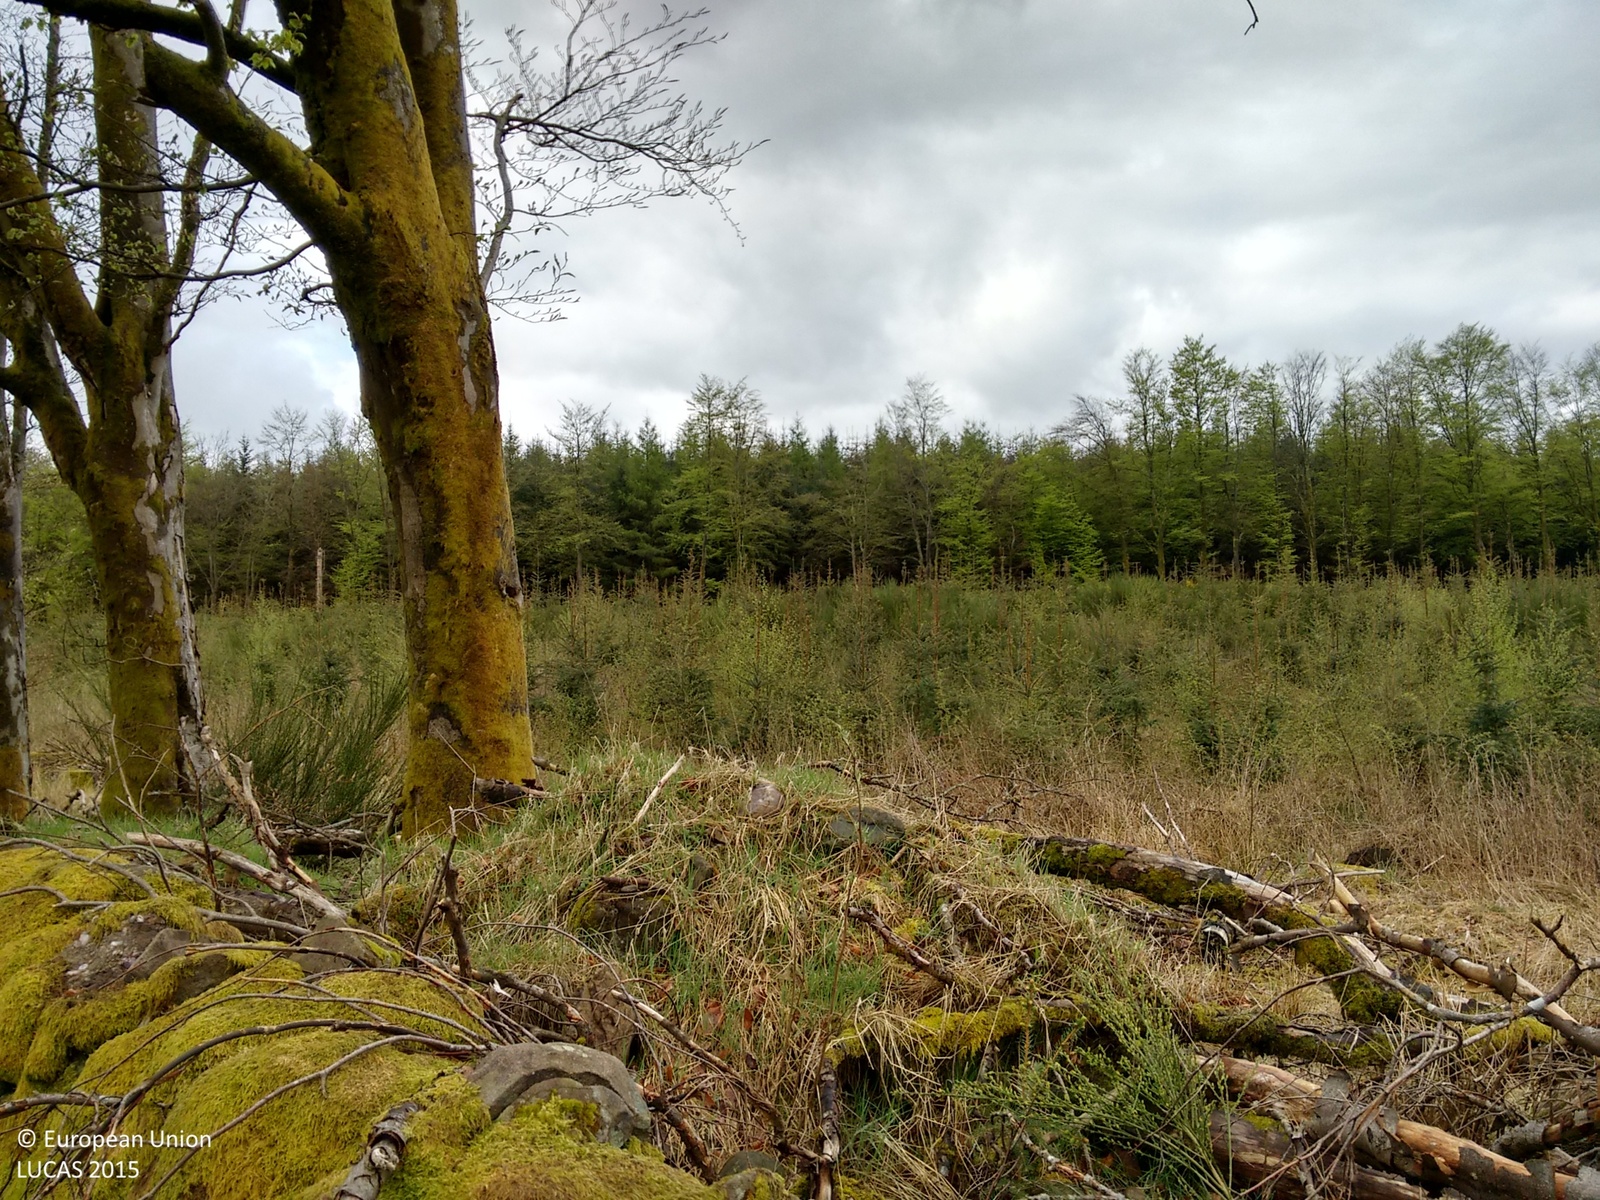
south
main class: Grassland
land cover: Grassland without tree/shrub cover
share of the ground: > 75 %
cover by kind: herbaceous plants 100 %
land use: Agriculture (excluding fallow land and kitchen gardens)
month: May
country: GB
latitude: 56.2086
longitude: -4.0983
